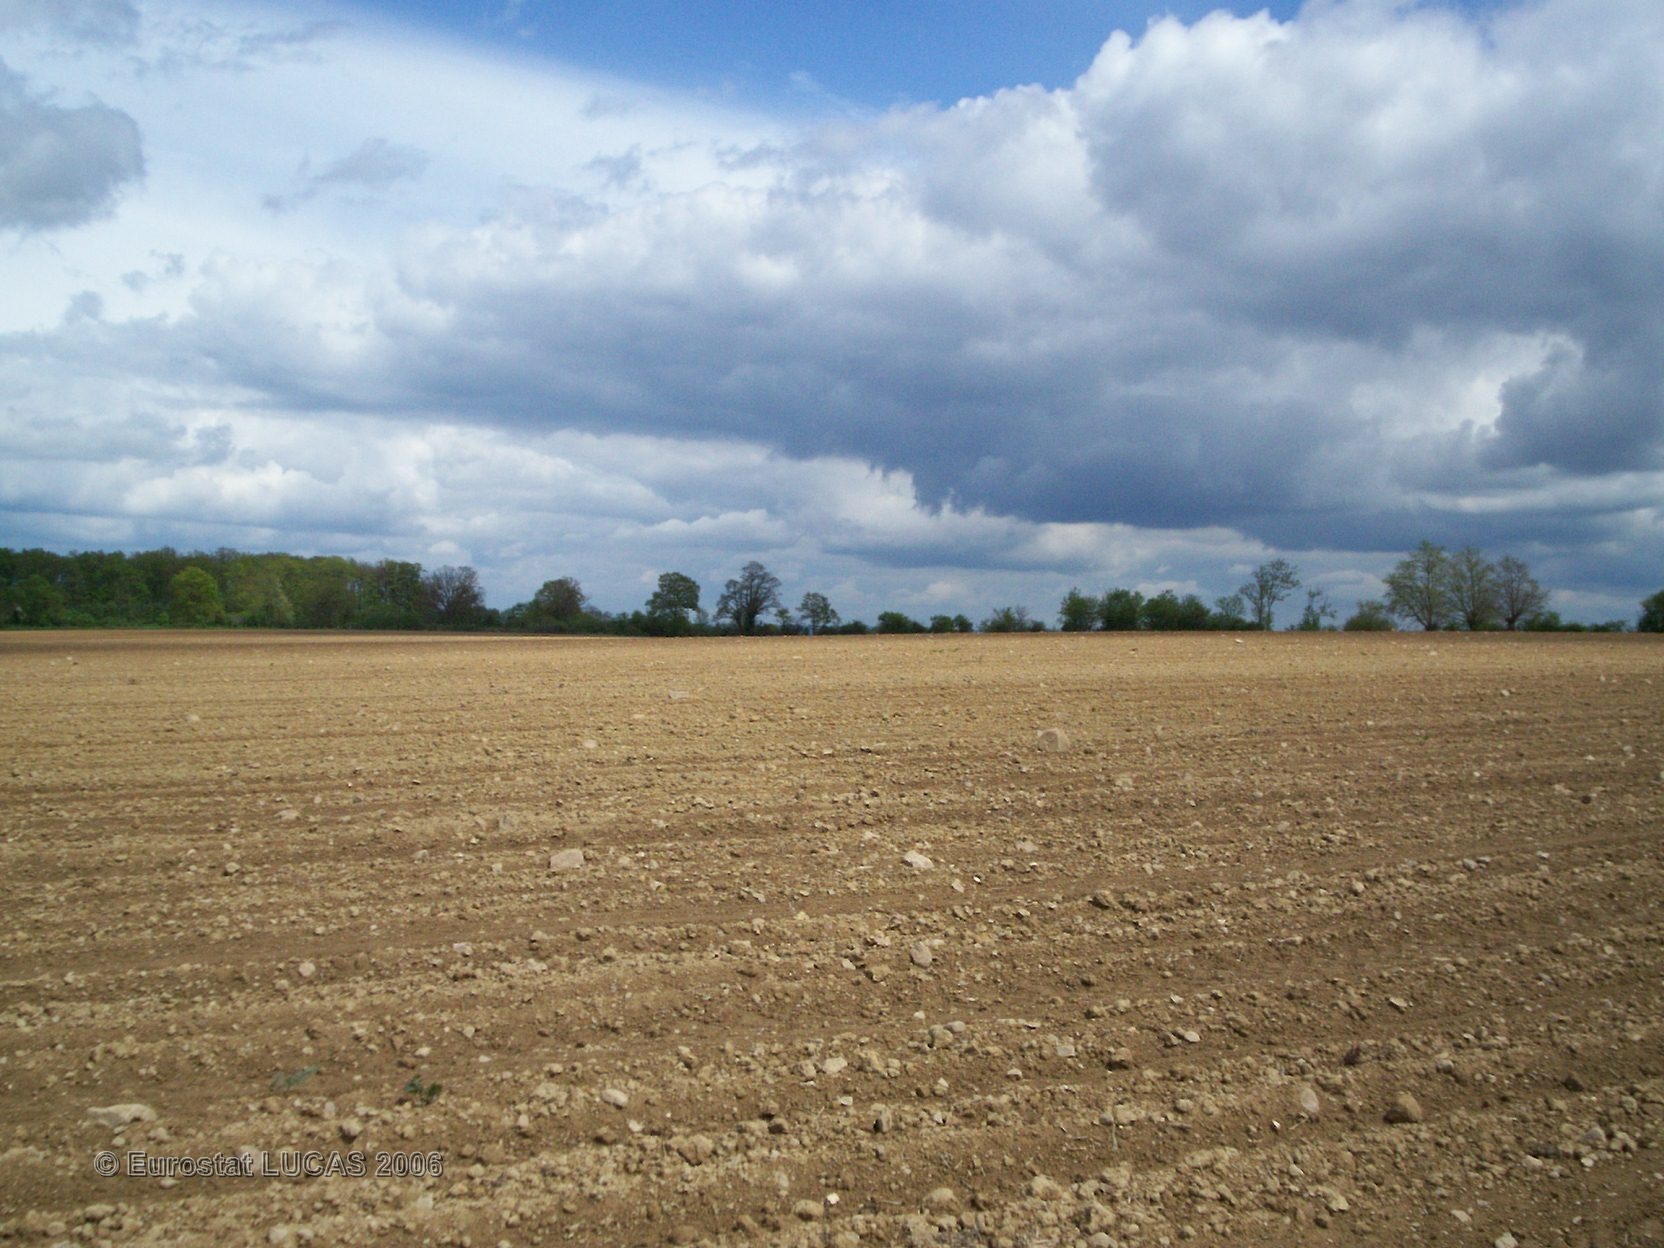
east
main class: Cropland
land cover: Maize
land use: Agriculture (excluding fallow land and kitchen gardens)
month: May
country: FR
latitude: 48.6246
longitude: 0.0532
